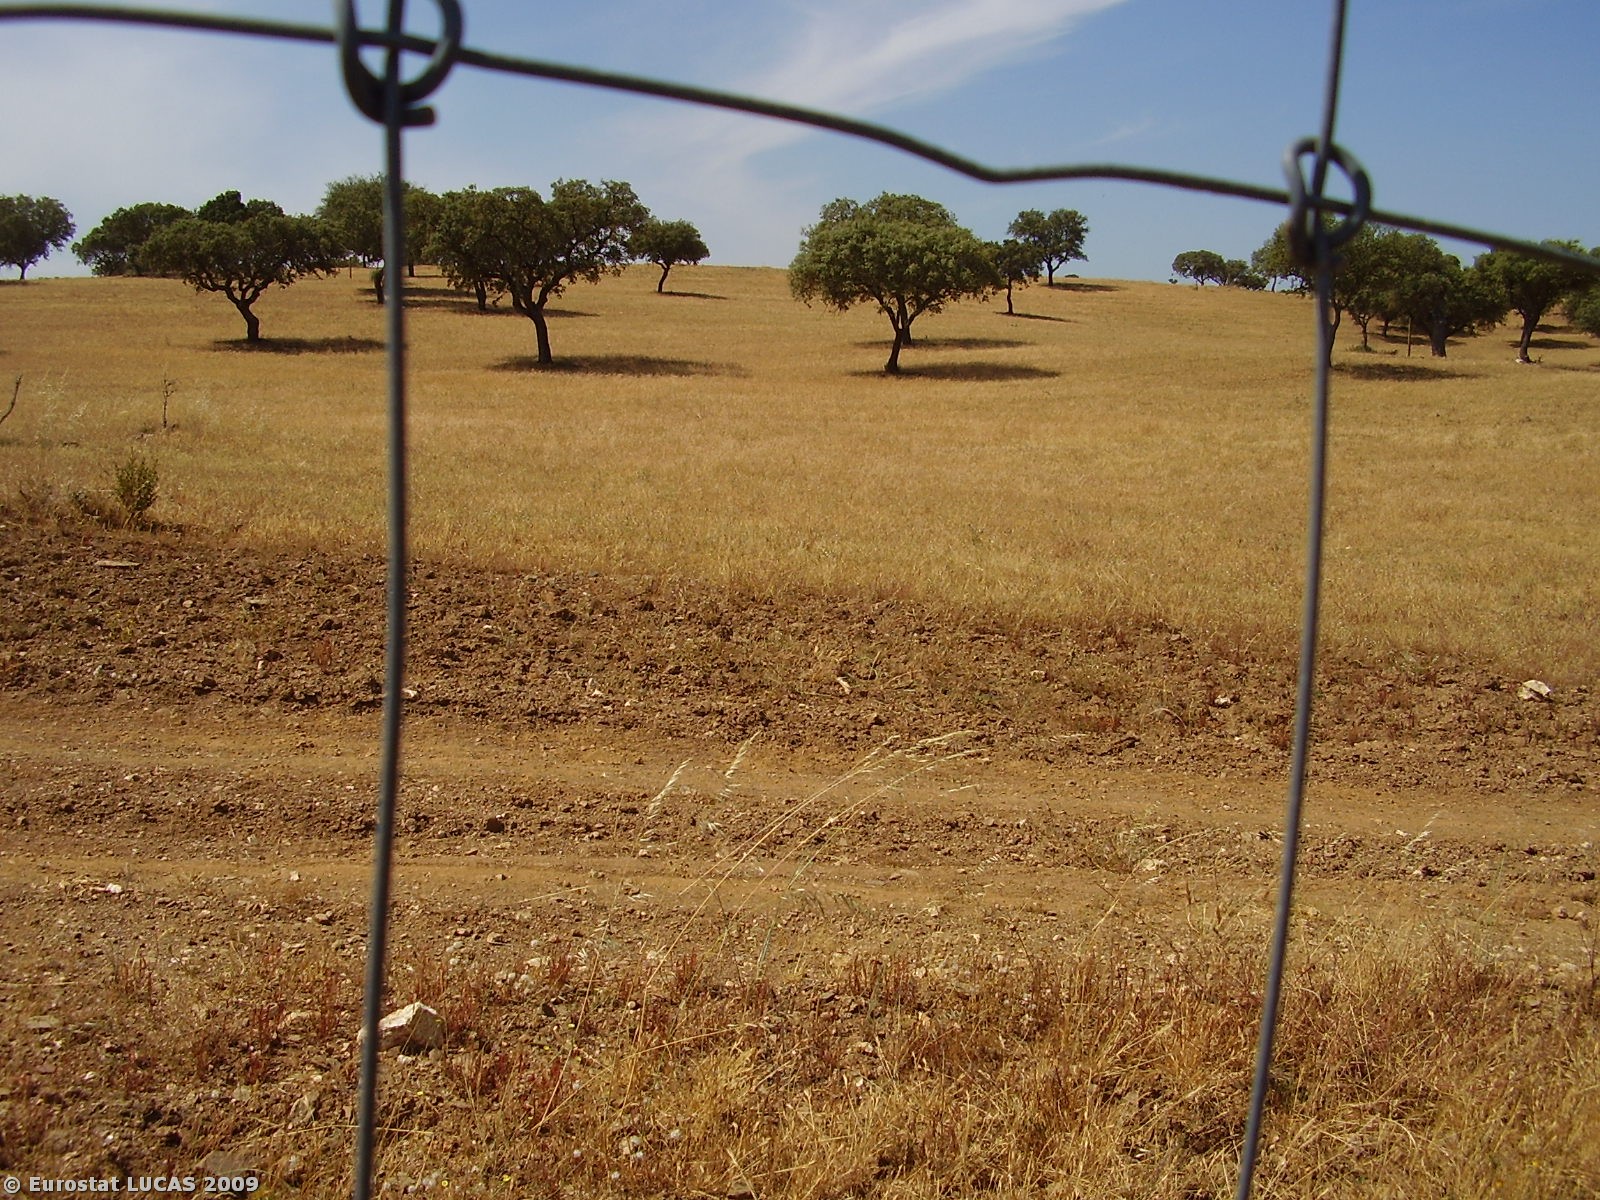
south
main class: Woodland
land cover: Broadleaved woodland
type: broadleaved evergreen forest
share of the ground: 10 - 25 %
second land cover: Spontaneously vegetated surfaces
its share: > 75 %
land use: Forestry
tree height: > 5 m
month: May
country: PT
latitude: 37.7000
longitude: -7.6068
